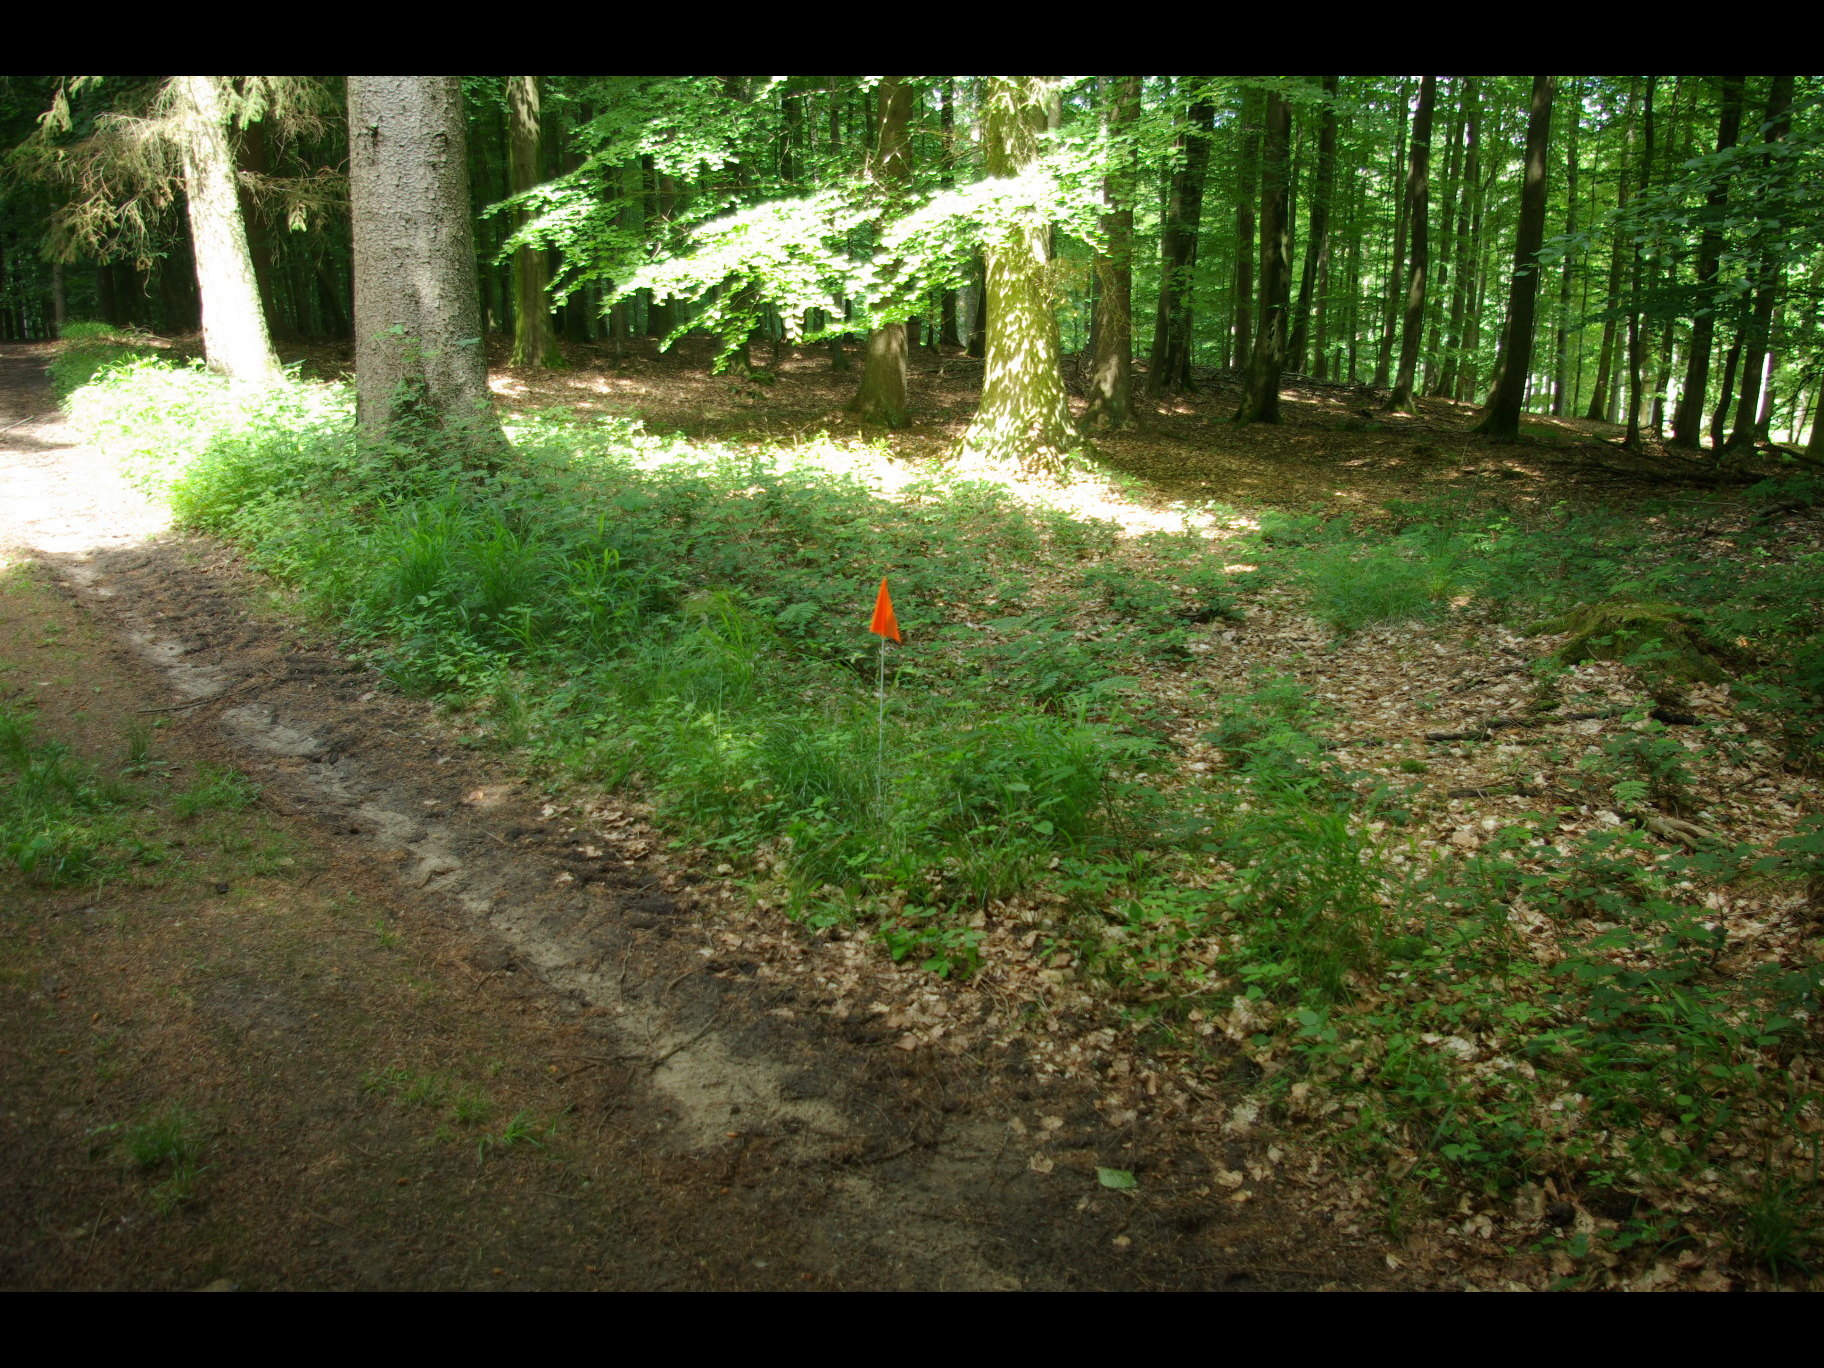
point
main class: Woodland
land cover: Other mixed woodland
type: hemiboreal forest and nemoral coniferous forest and mixed broadleaved-coniferous forest
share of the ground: > 75 %
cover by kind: coniferous forest trees 45 %, broadleaved forest trees 45 %, herbaceous plants 5 %, unconsolidated bare surface 5 %
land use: Forestry
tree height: > 5 m
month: June
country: DE
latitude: 54.3005
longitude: 9.8925
